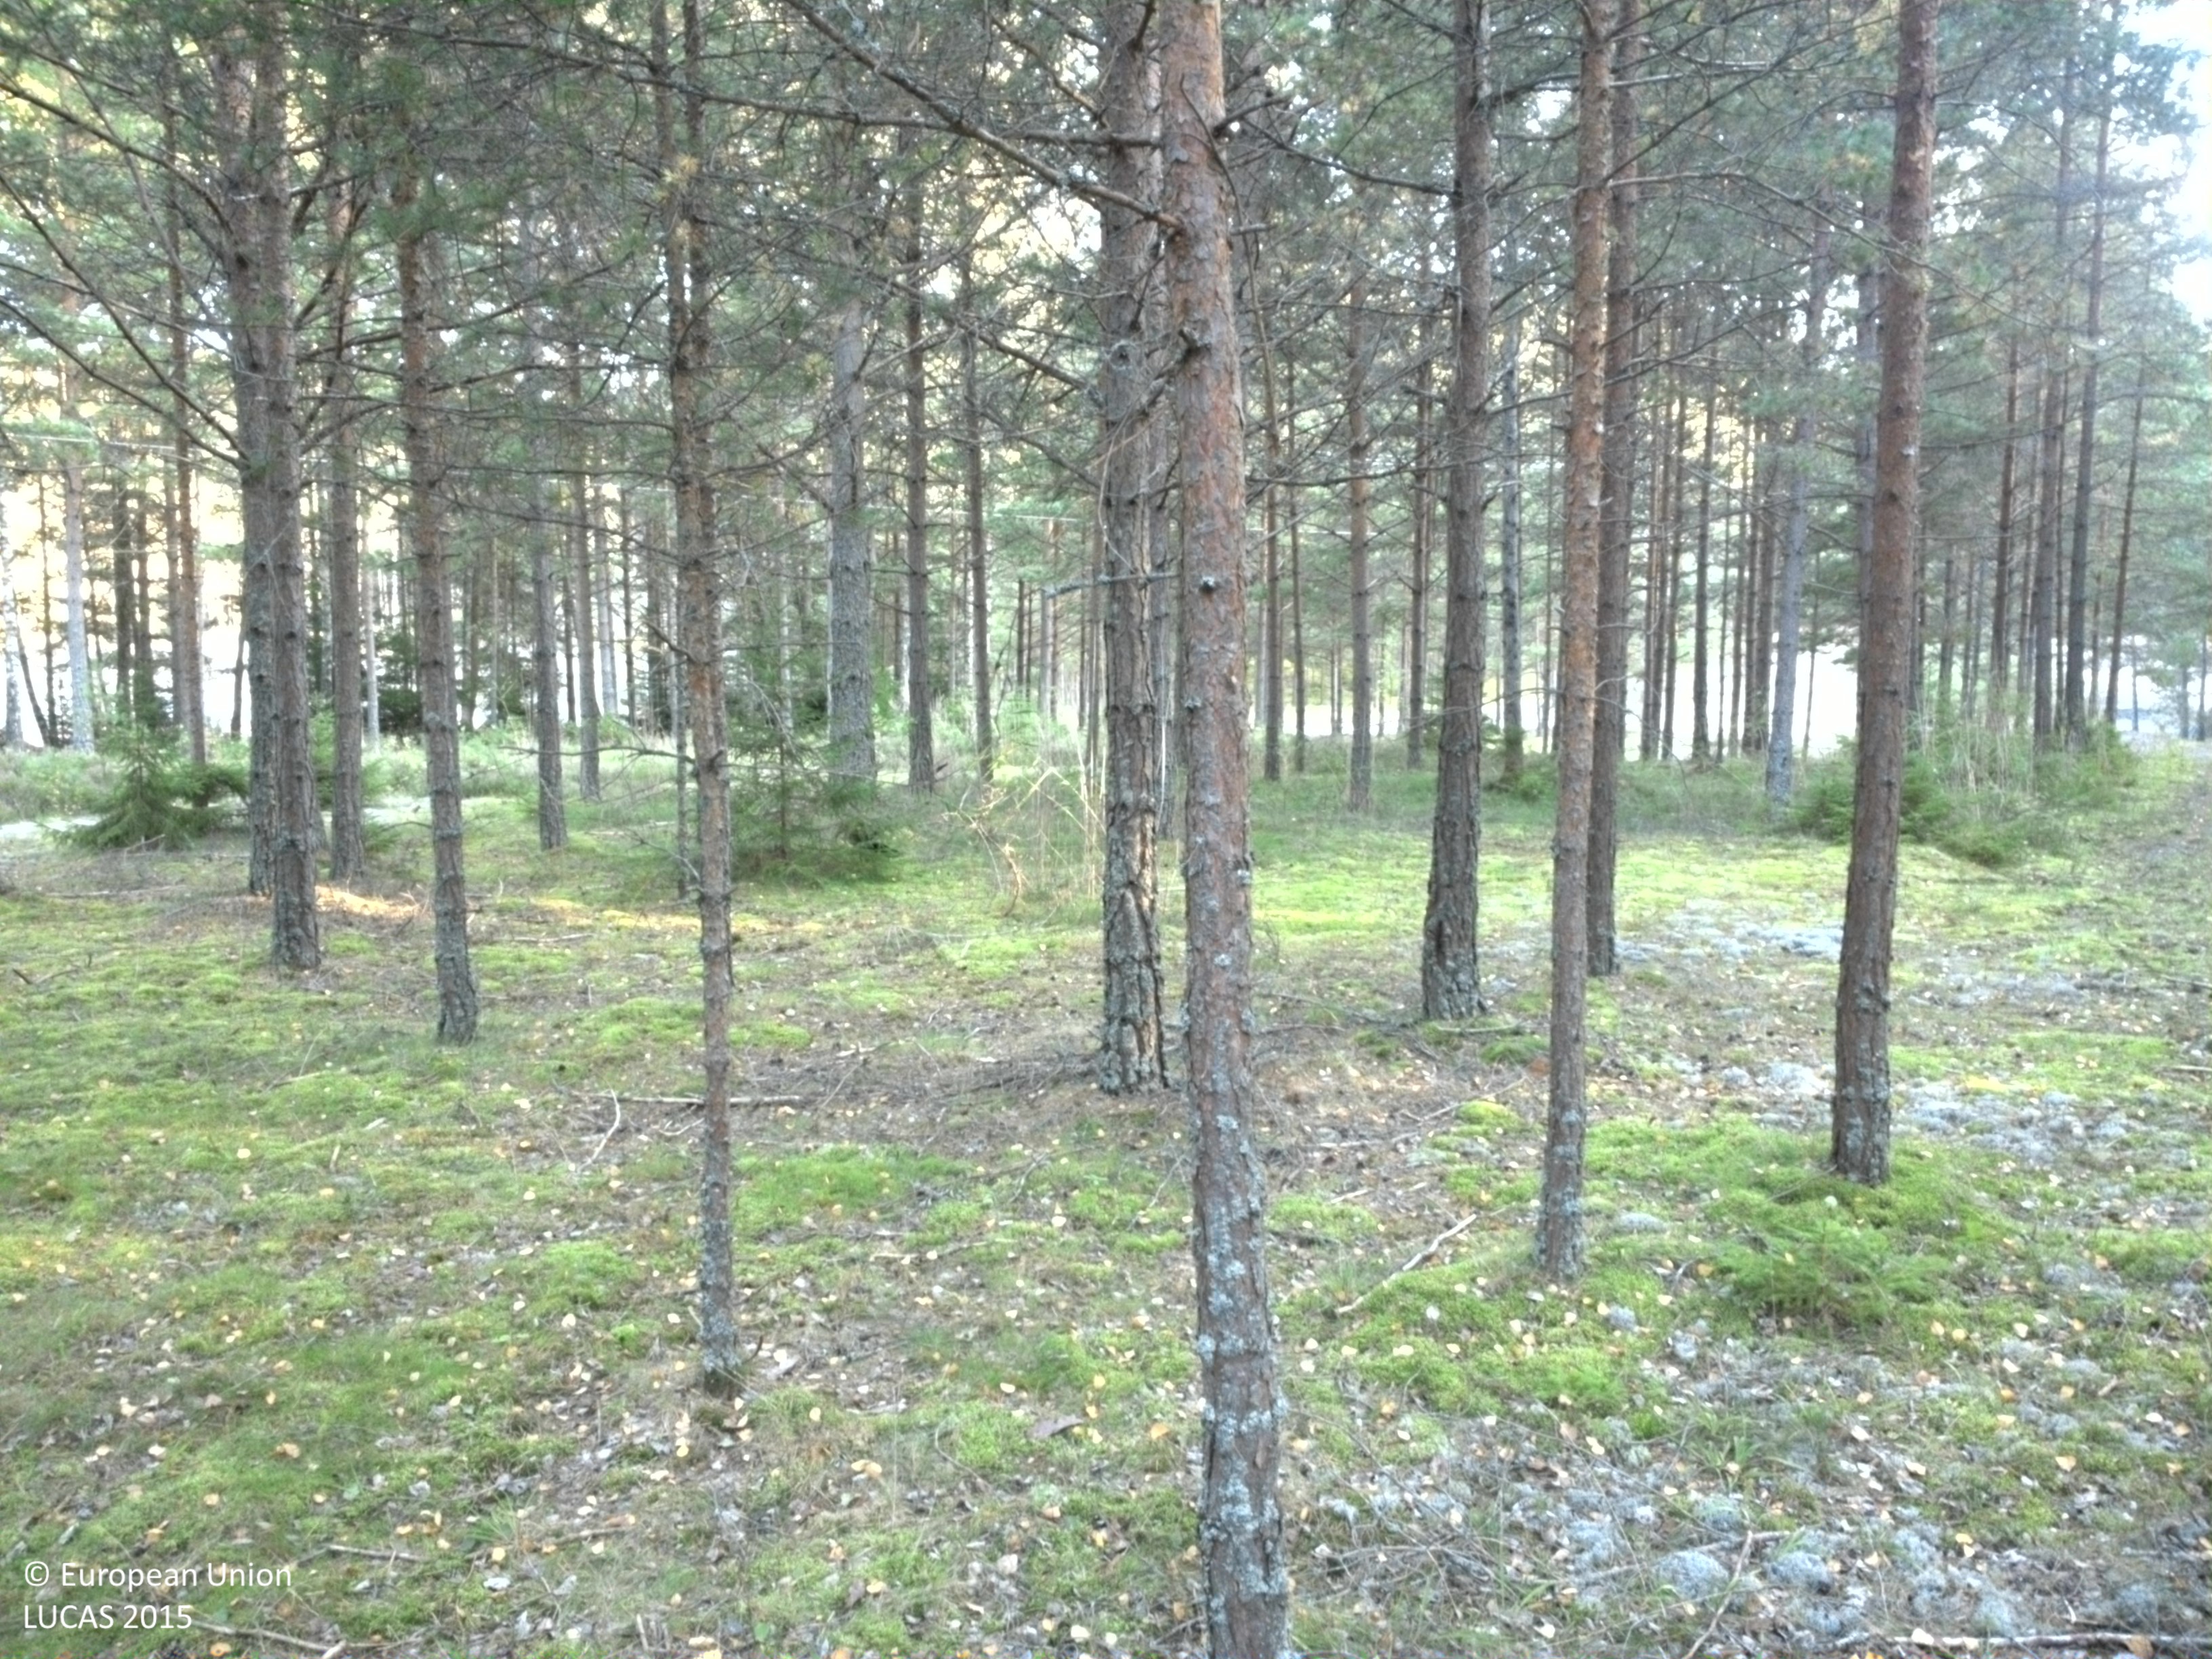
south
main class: Woodland
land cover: Pine dominated coniferous woodland
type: boreal forest
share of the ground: 50 - 75 %
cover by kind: coniferous forest trees 60 %, lichens and mosses 25 %, broadleaved forest trees 10 %, unconsolidated bare surface 5 %
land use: Amenities, museums, leisure
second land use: Sport
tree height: > 5 m
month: September
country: SE
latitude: 59.2959
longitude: 18.6937
